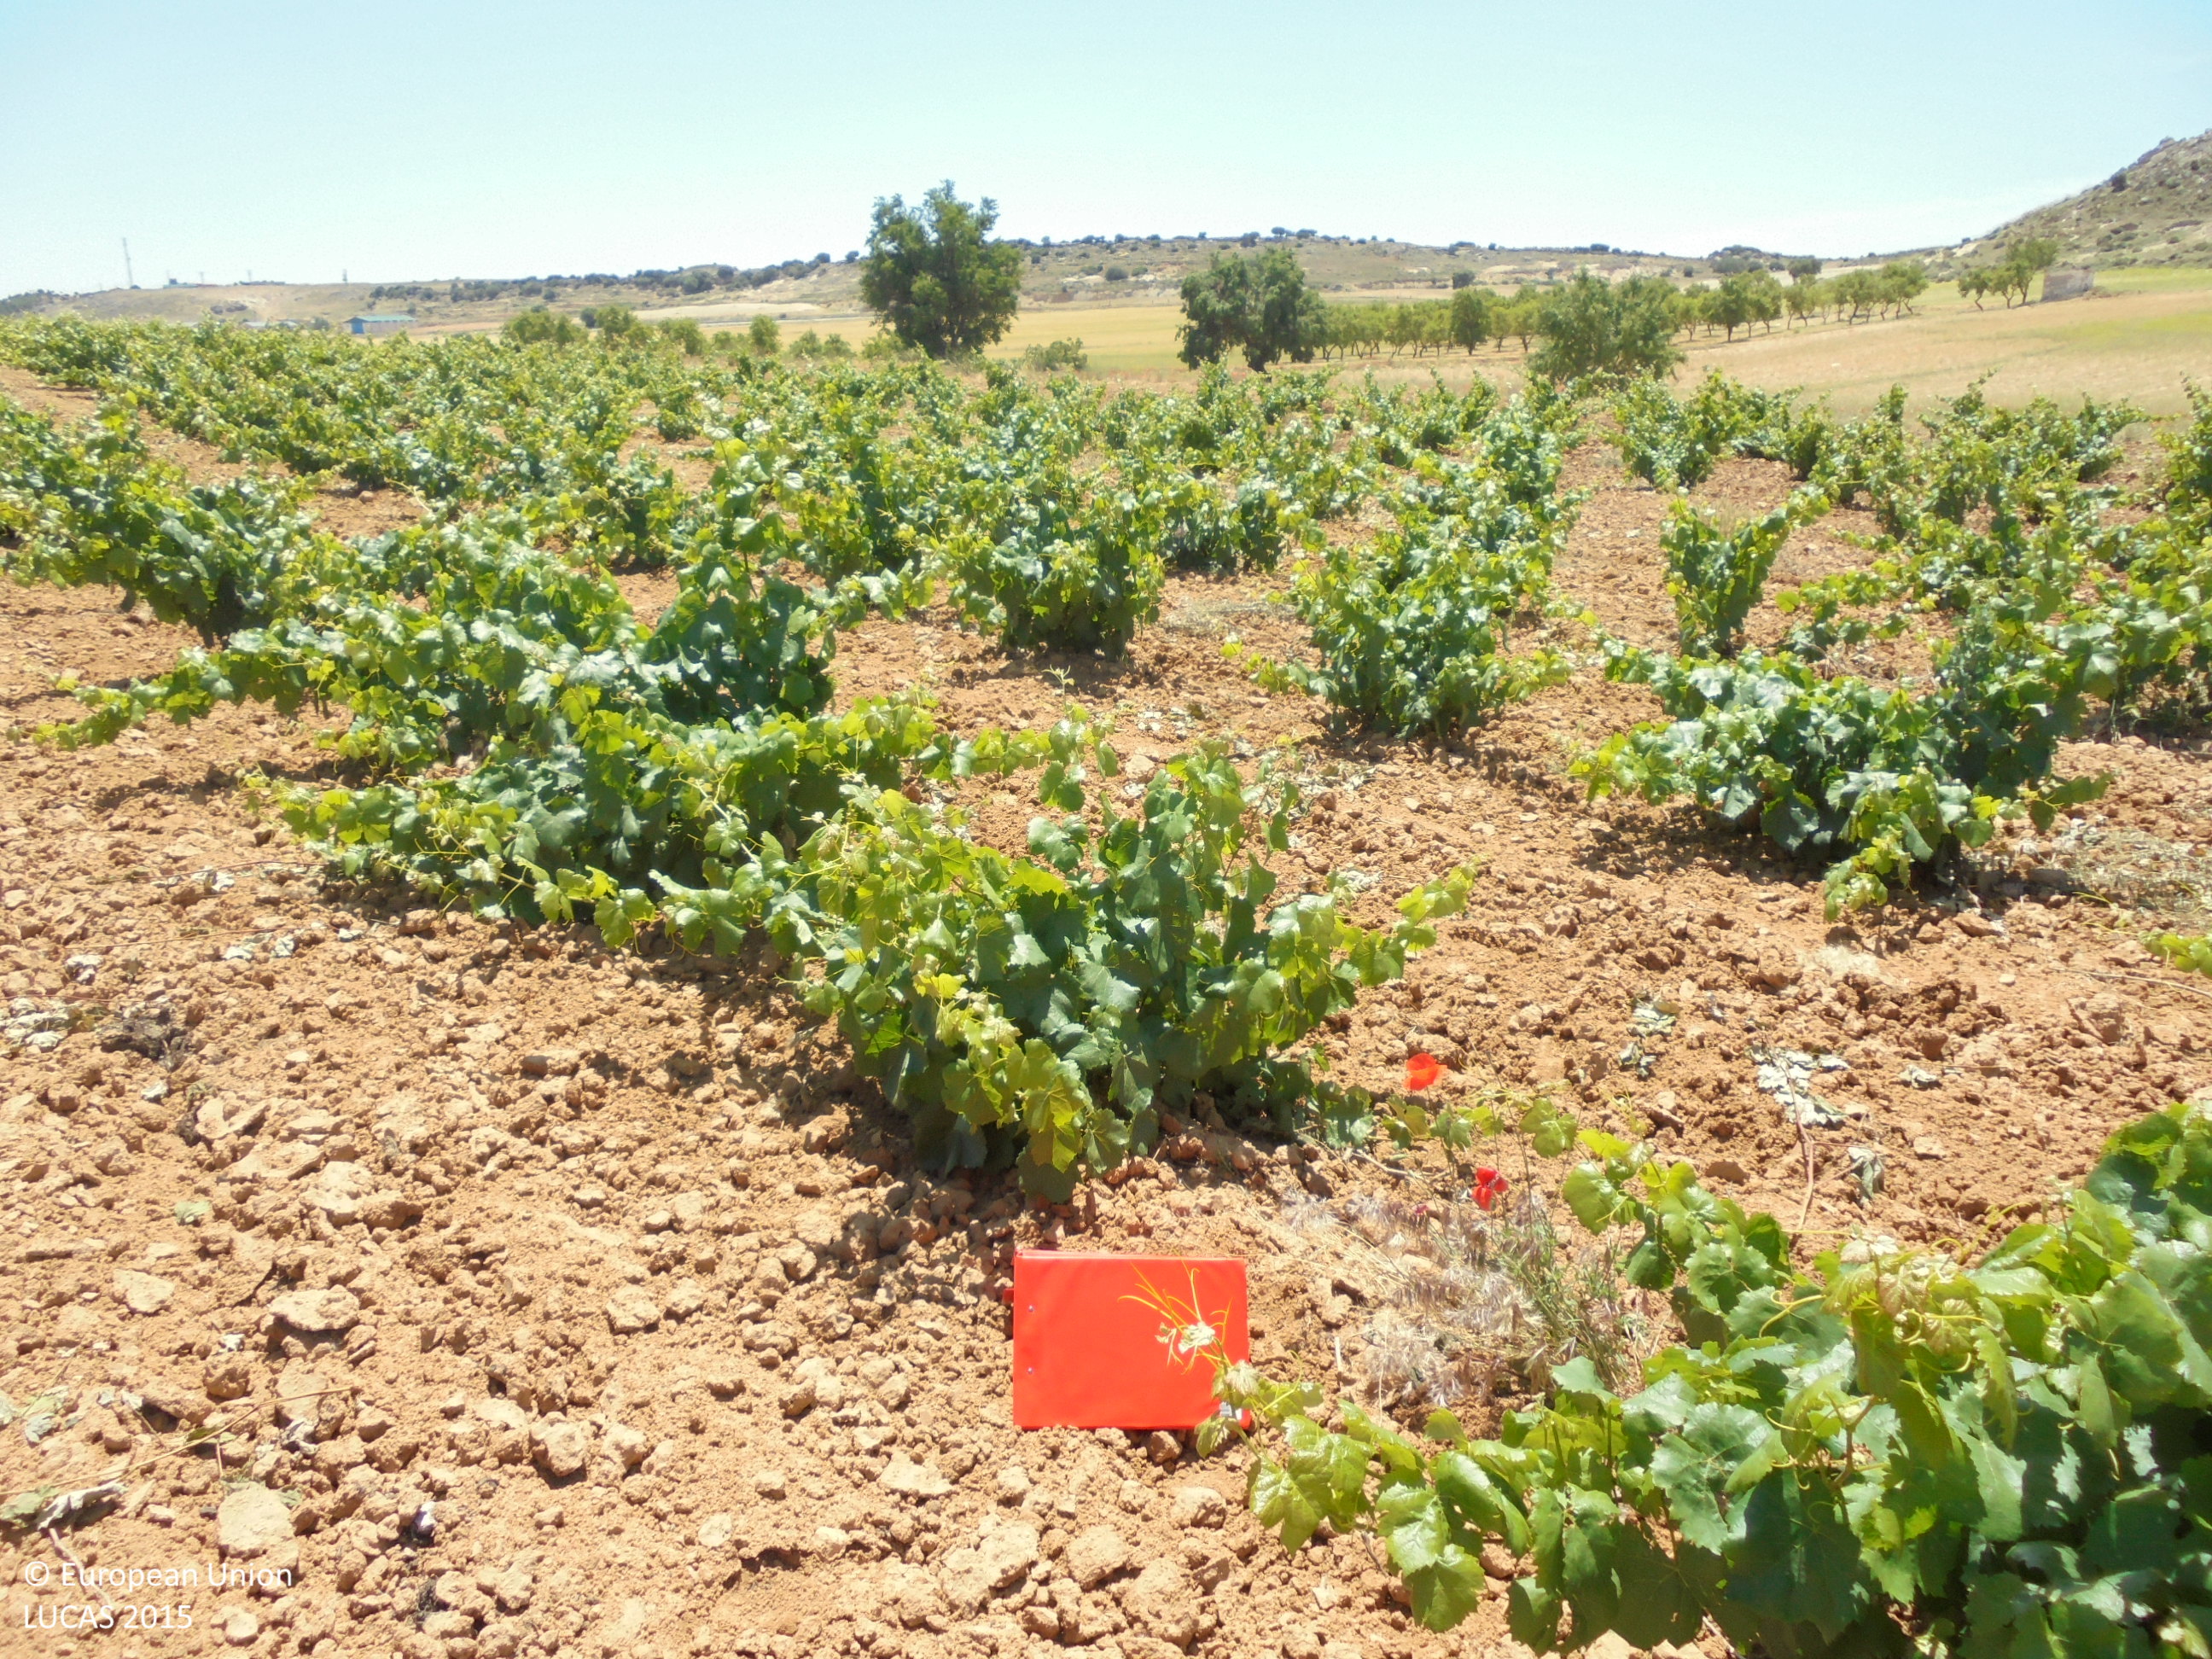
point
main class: Cropland
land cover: Vineyards
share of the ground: 25 - 50 %
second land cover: Other bare soil
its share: > 75 %
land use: Agriculture (excluding fallow land and kitchen gardens)
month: June
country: ES
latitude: 38.8309
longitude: -1.5734
